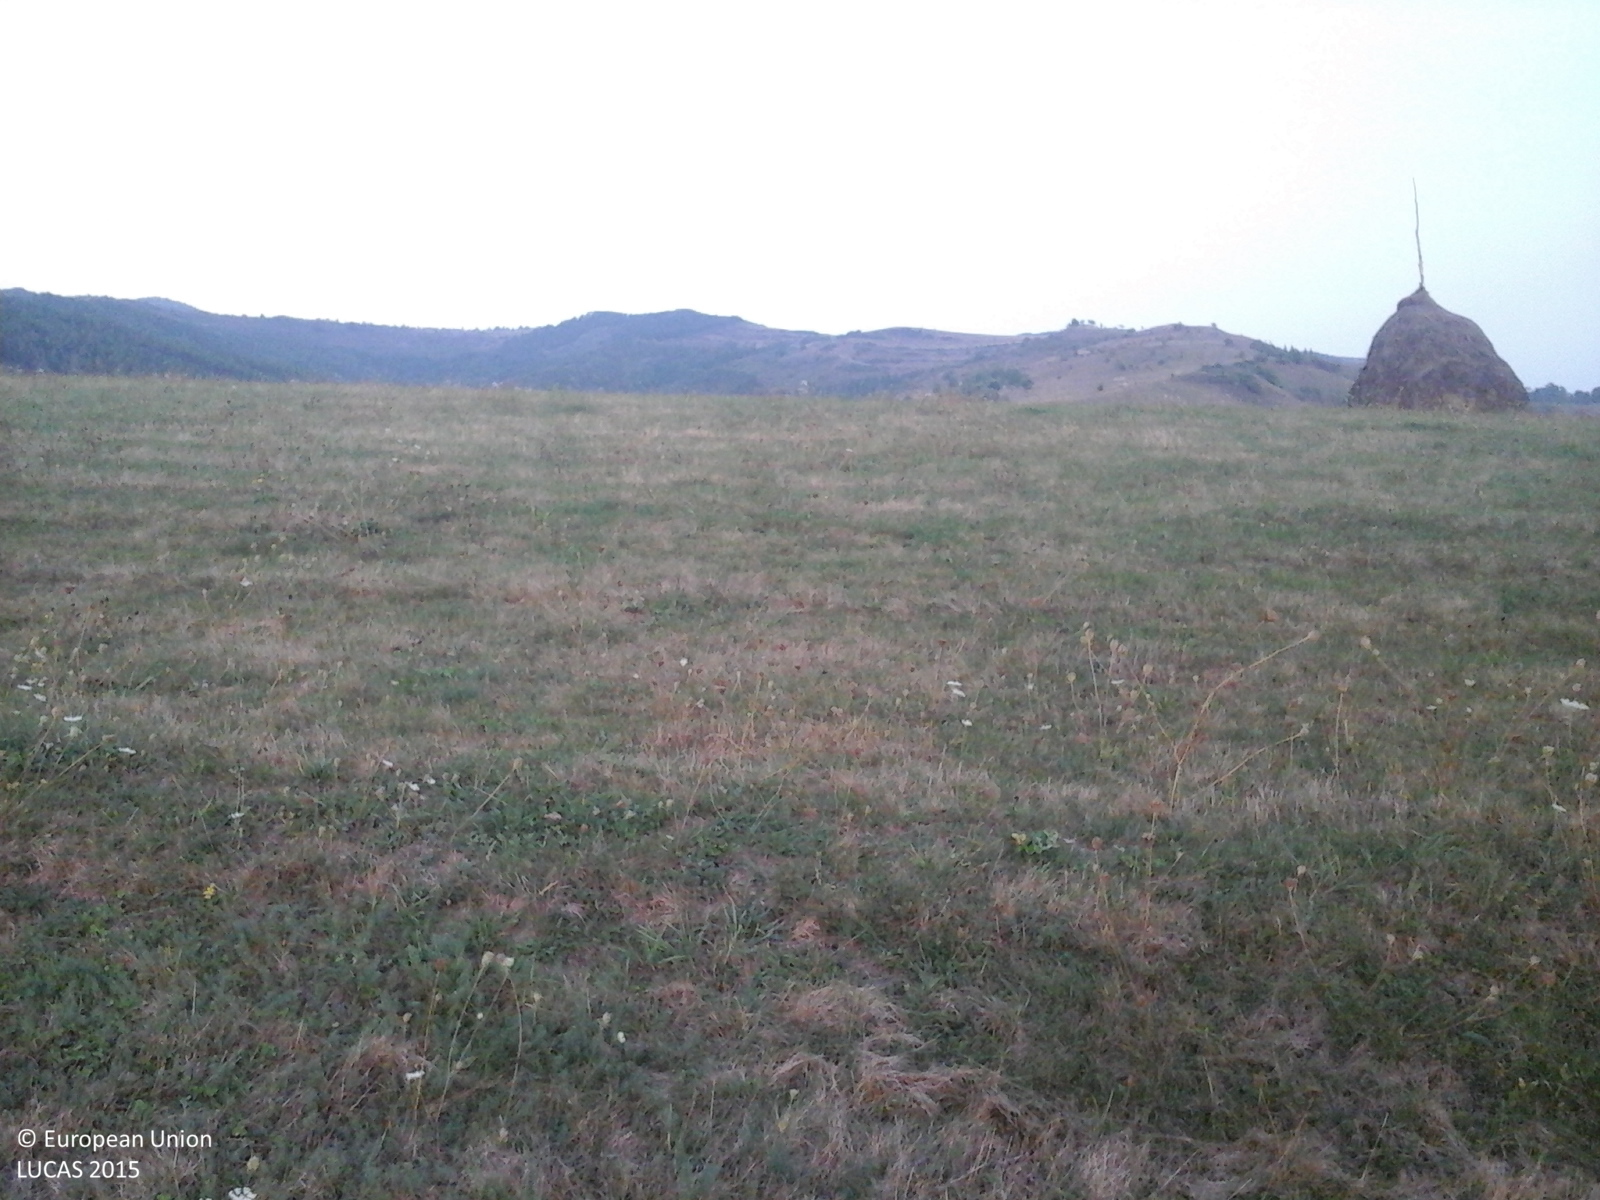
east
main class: Grassland
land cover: Grassland without tree/shrub cover
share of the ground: > 75 %
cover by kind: herbaceous plants 100 %
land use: Agriculture (excluding fallow land and kitchen gardens)
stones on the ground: < 10 %
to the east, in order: Grassland without tree/shrub cover; Shruby margins; Grassland without tree/shrub cover; Tracks; Grassland without tree/shrub cover
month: September
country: RO
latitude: 47.2480
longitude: 23.8863
